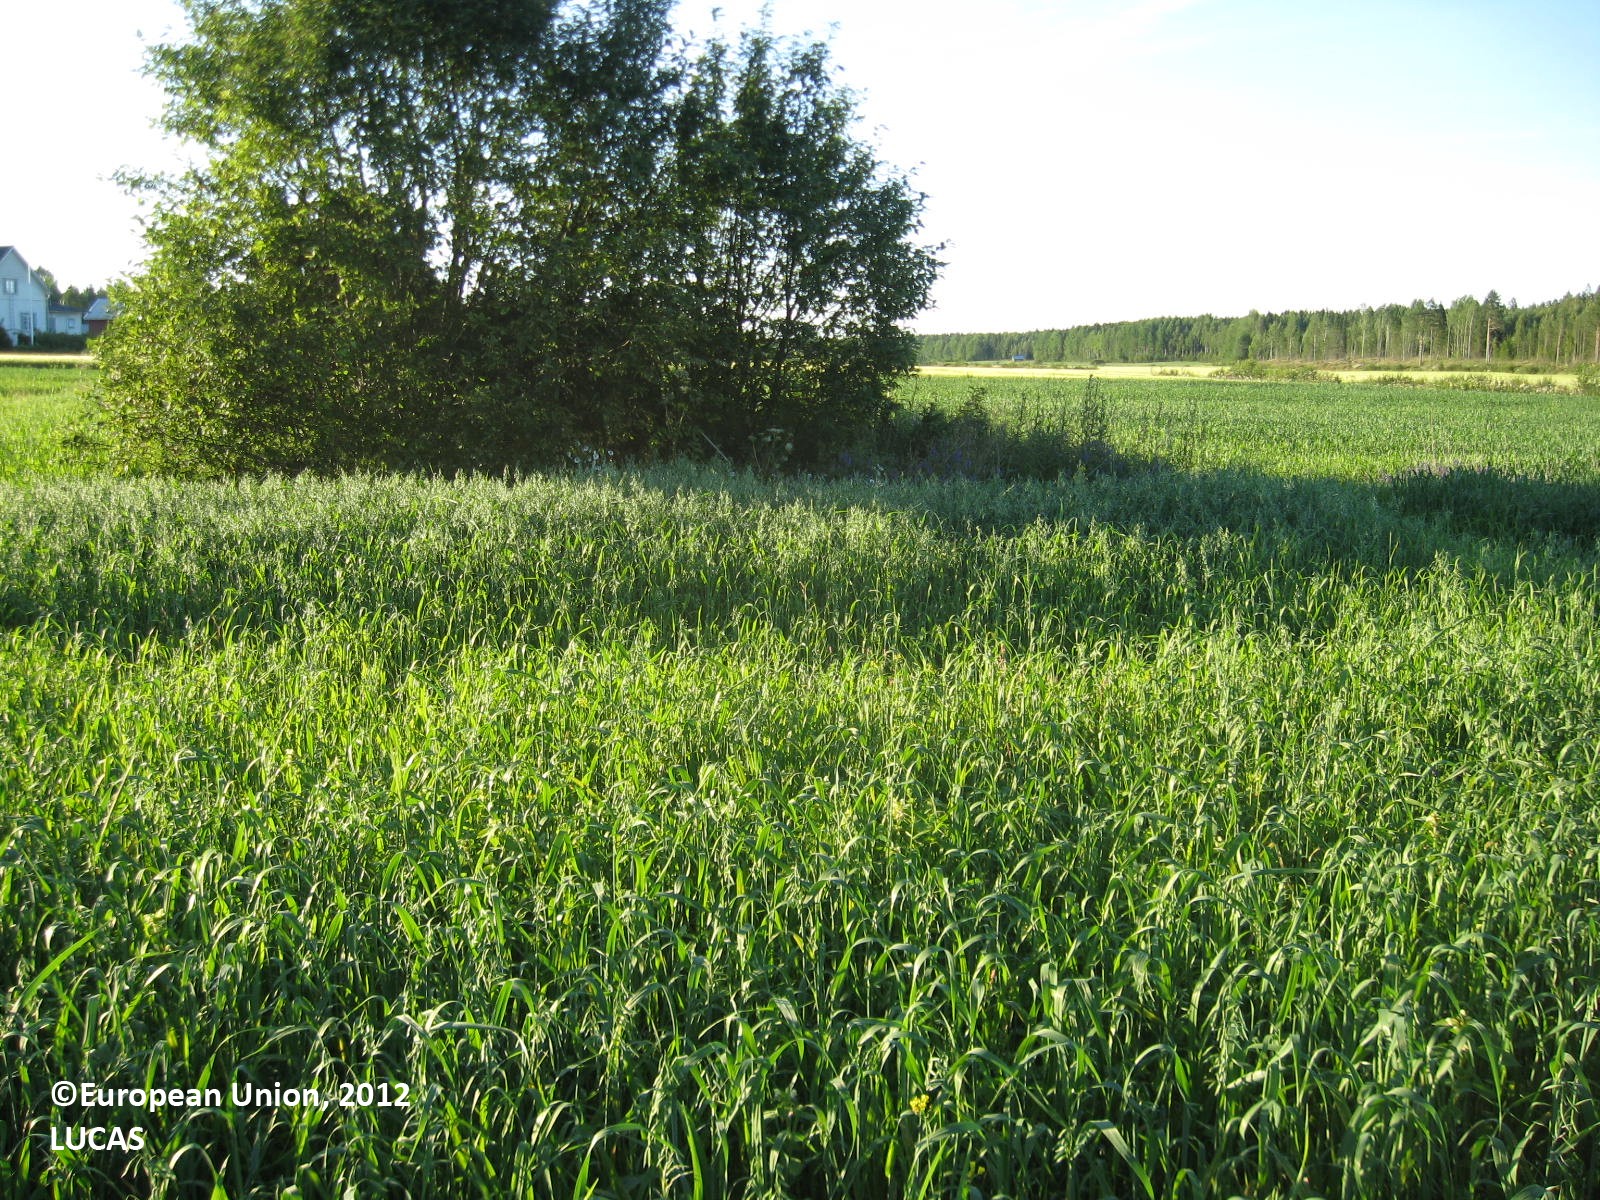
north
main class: Cropland
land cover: Oats
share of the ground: > 75 %
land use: Agriculture (excluding fallow land and kitchen gardens)
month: July
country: FI
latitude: 62.1460
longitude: 21.5774
